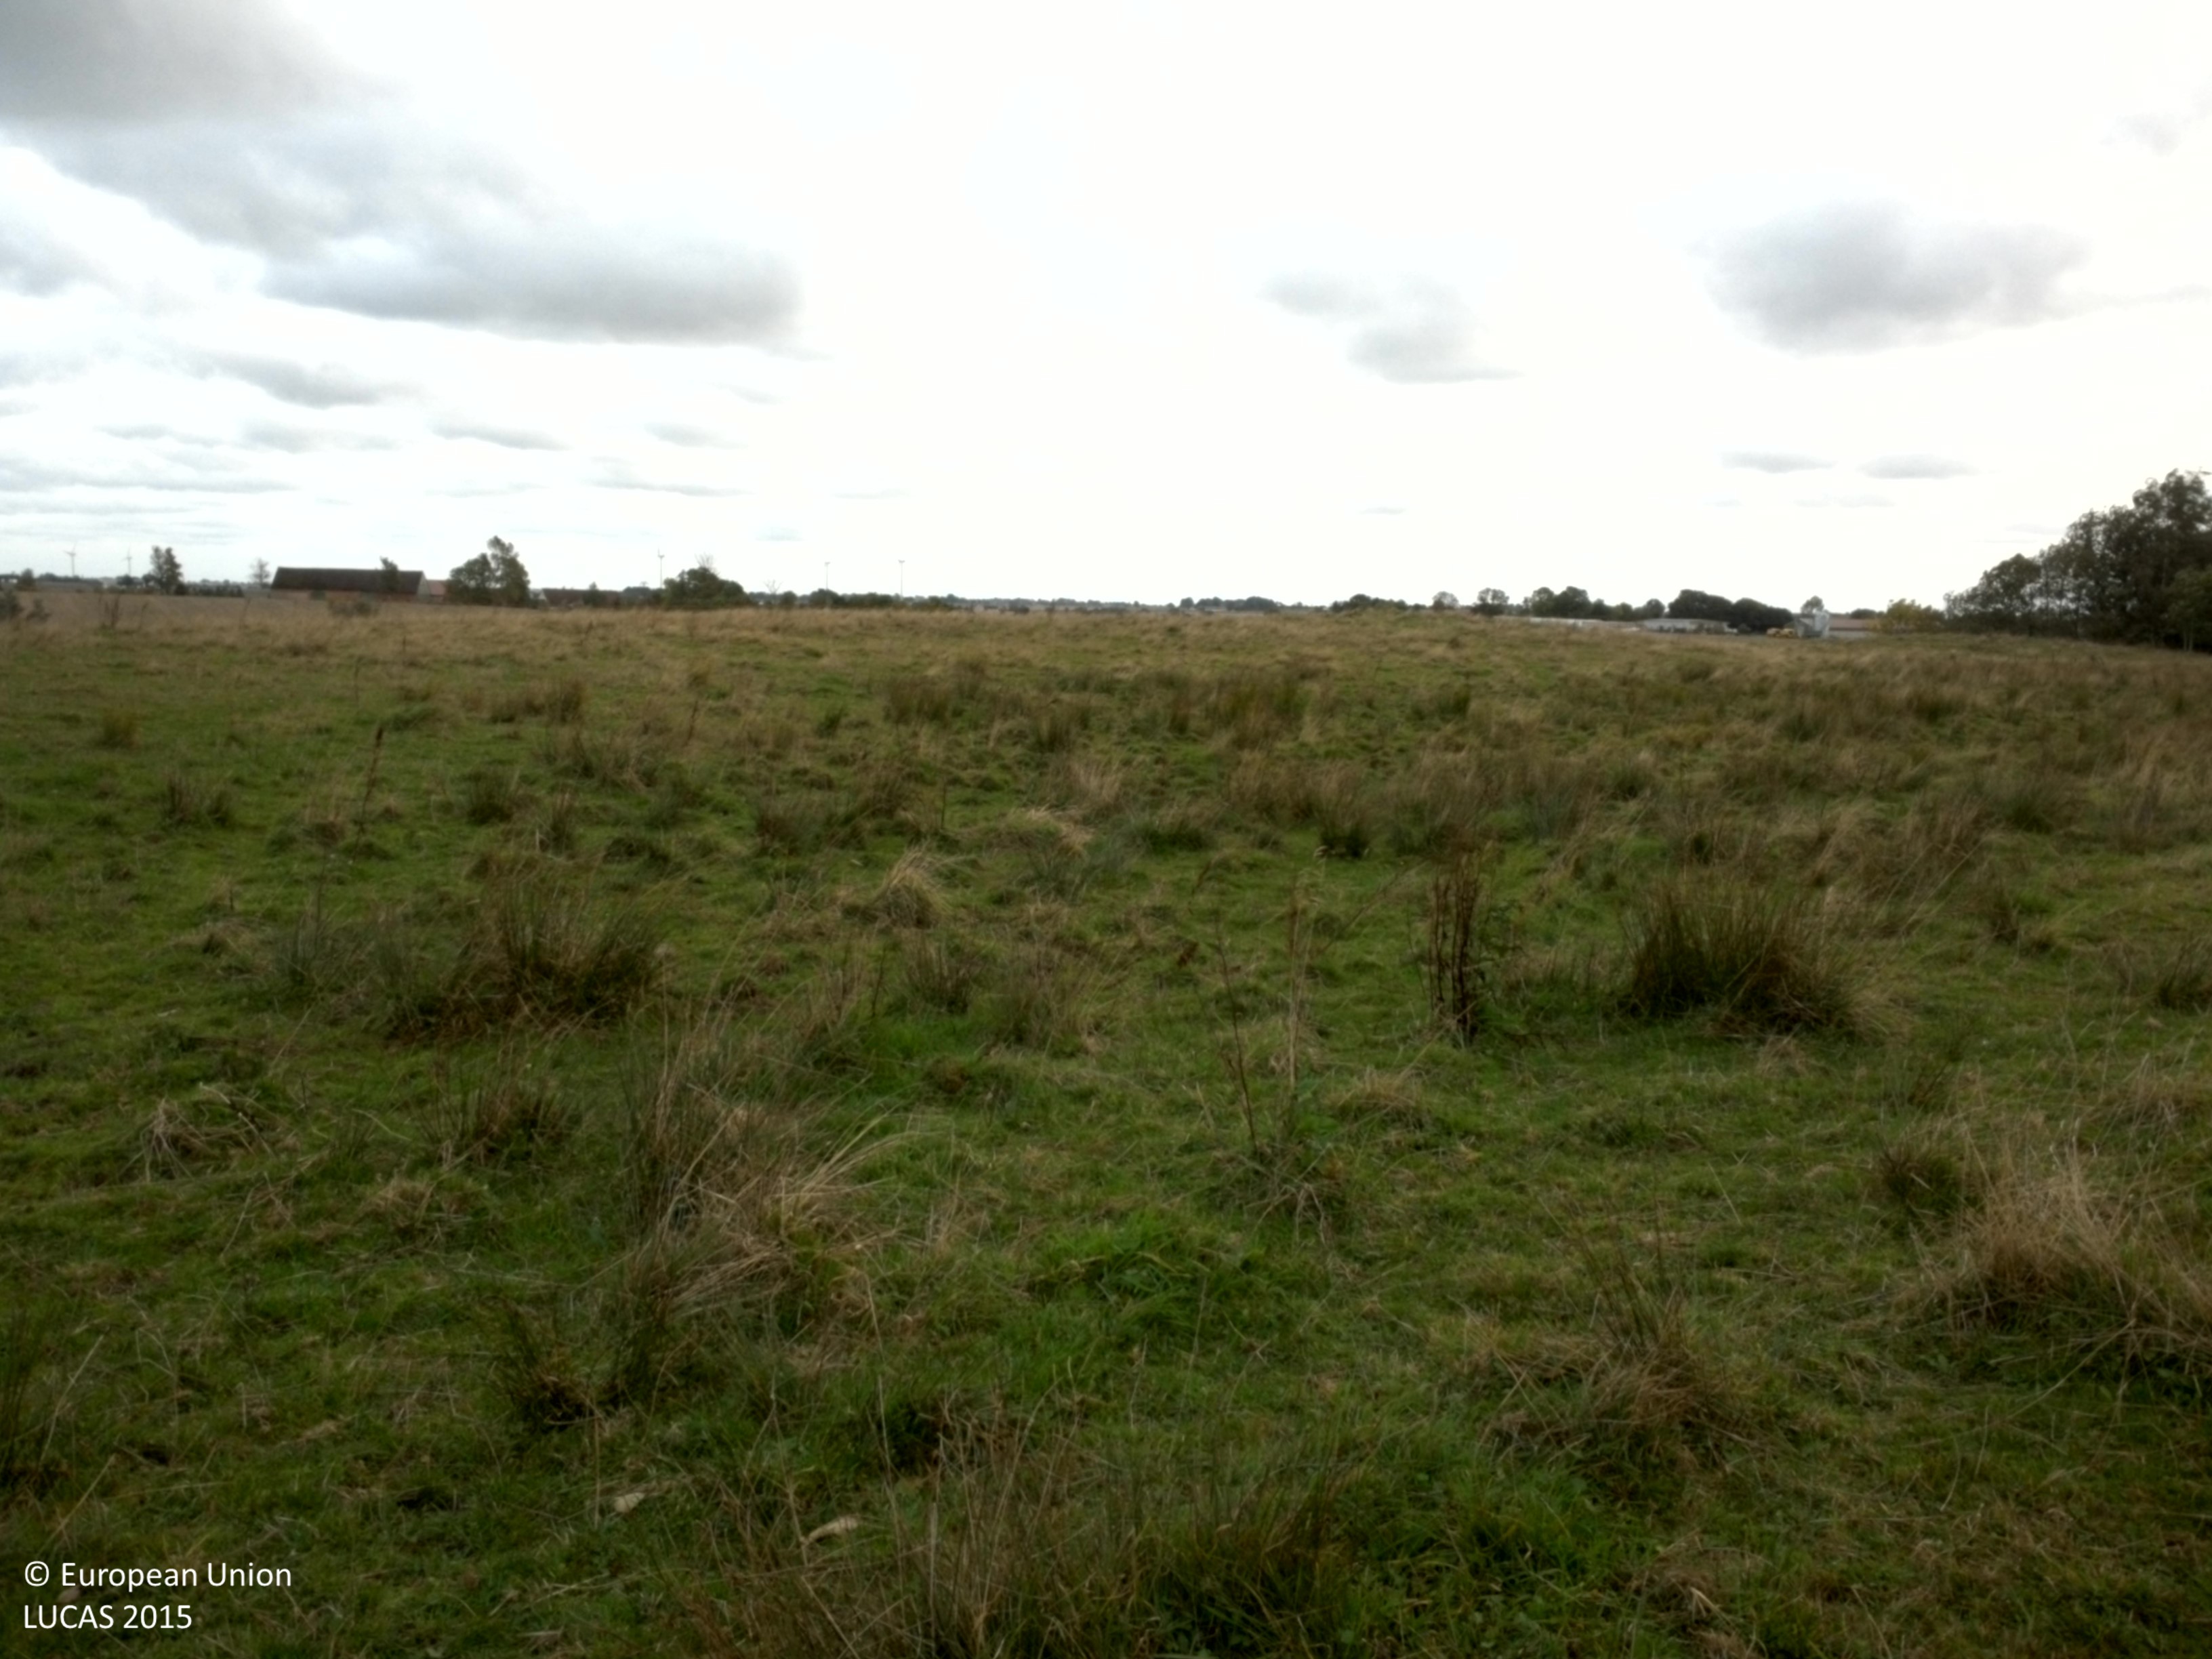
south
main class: Grassland
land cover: Grassland without tree/shrub cover
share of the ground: > 75 %
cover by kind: herbaceous plants 100 %
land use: Agriculture (excluding fallow land and kitchen gardens)
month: October
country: SE
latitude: 55.5631
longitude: 14.1370
